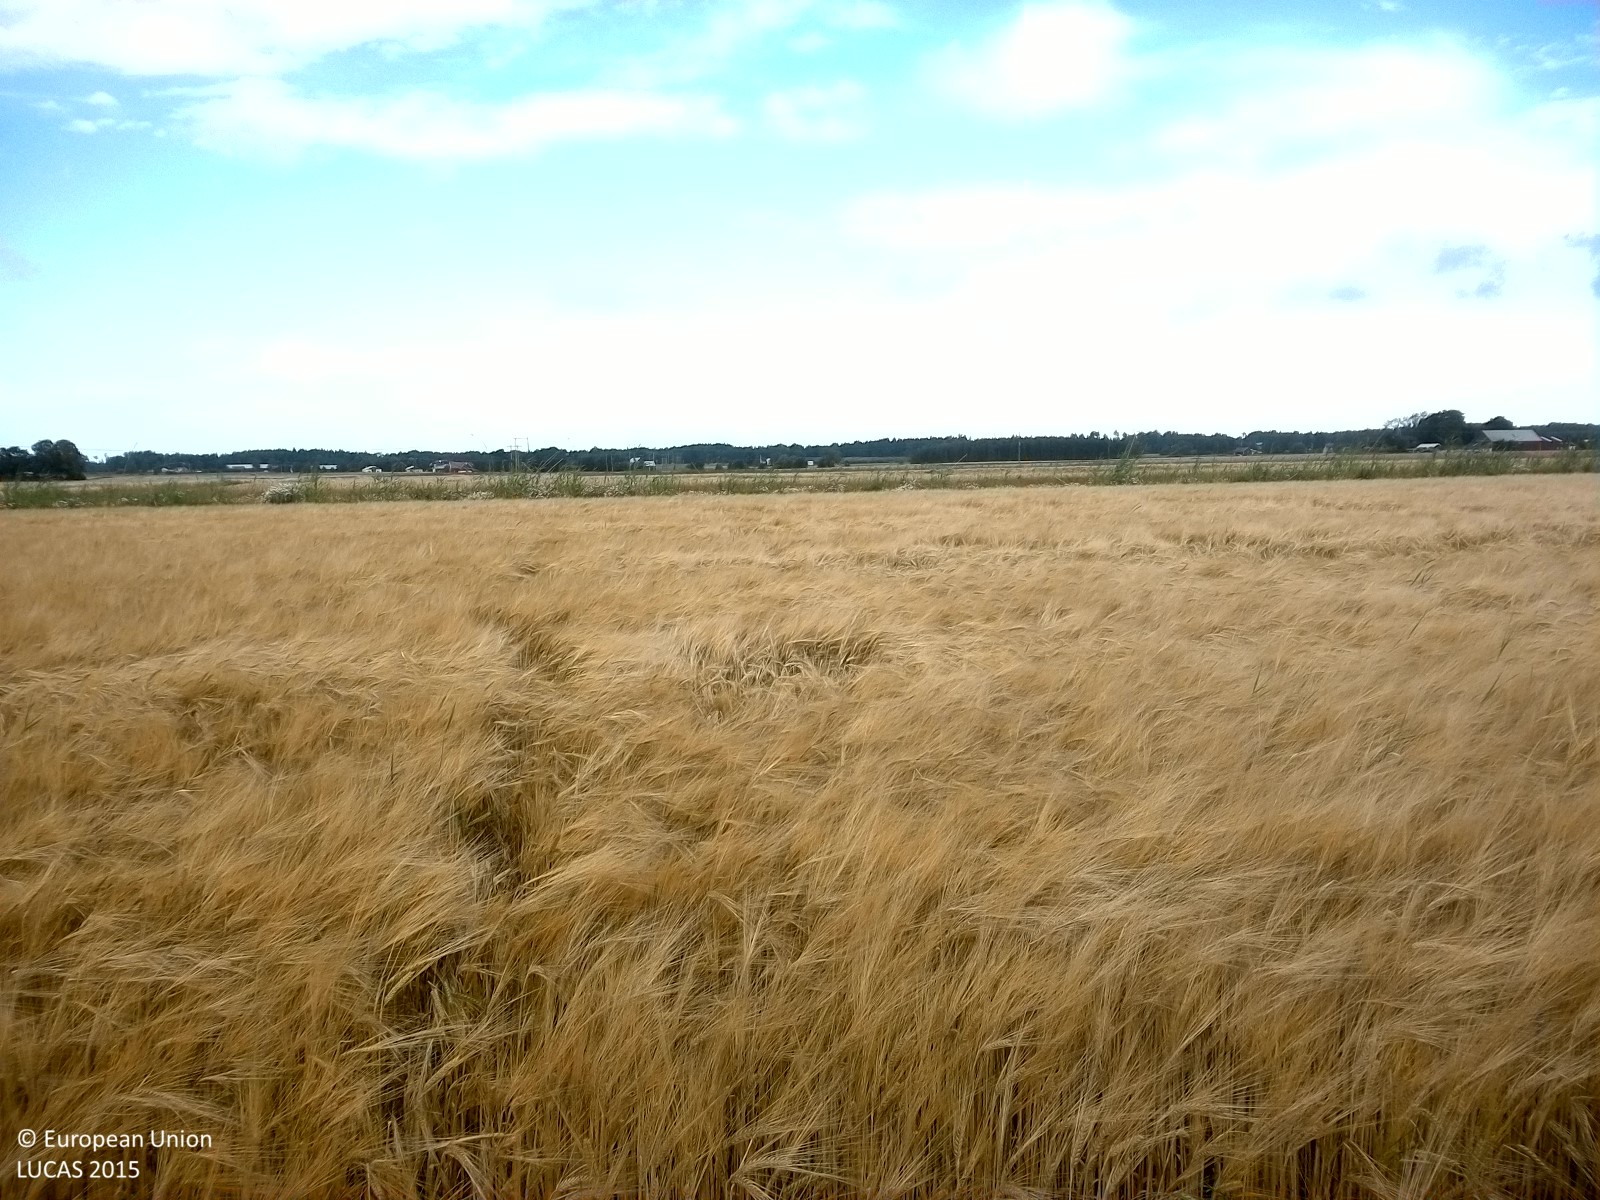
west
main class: Cropland
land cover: Barley
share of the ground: > 75 %
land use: Agriculture (excluding fallow land and kitchen gardens)
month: August
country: SE
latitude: 59.1141
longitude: 15.1094
